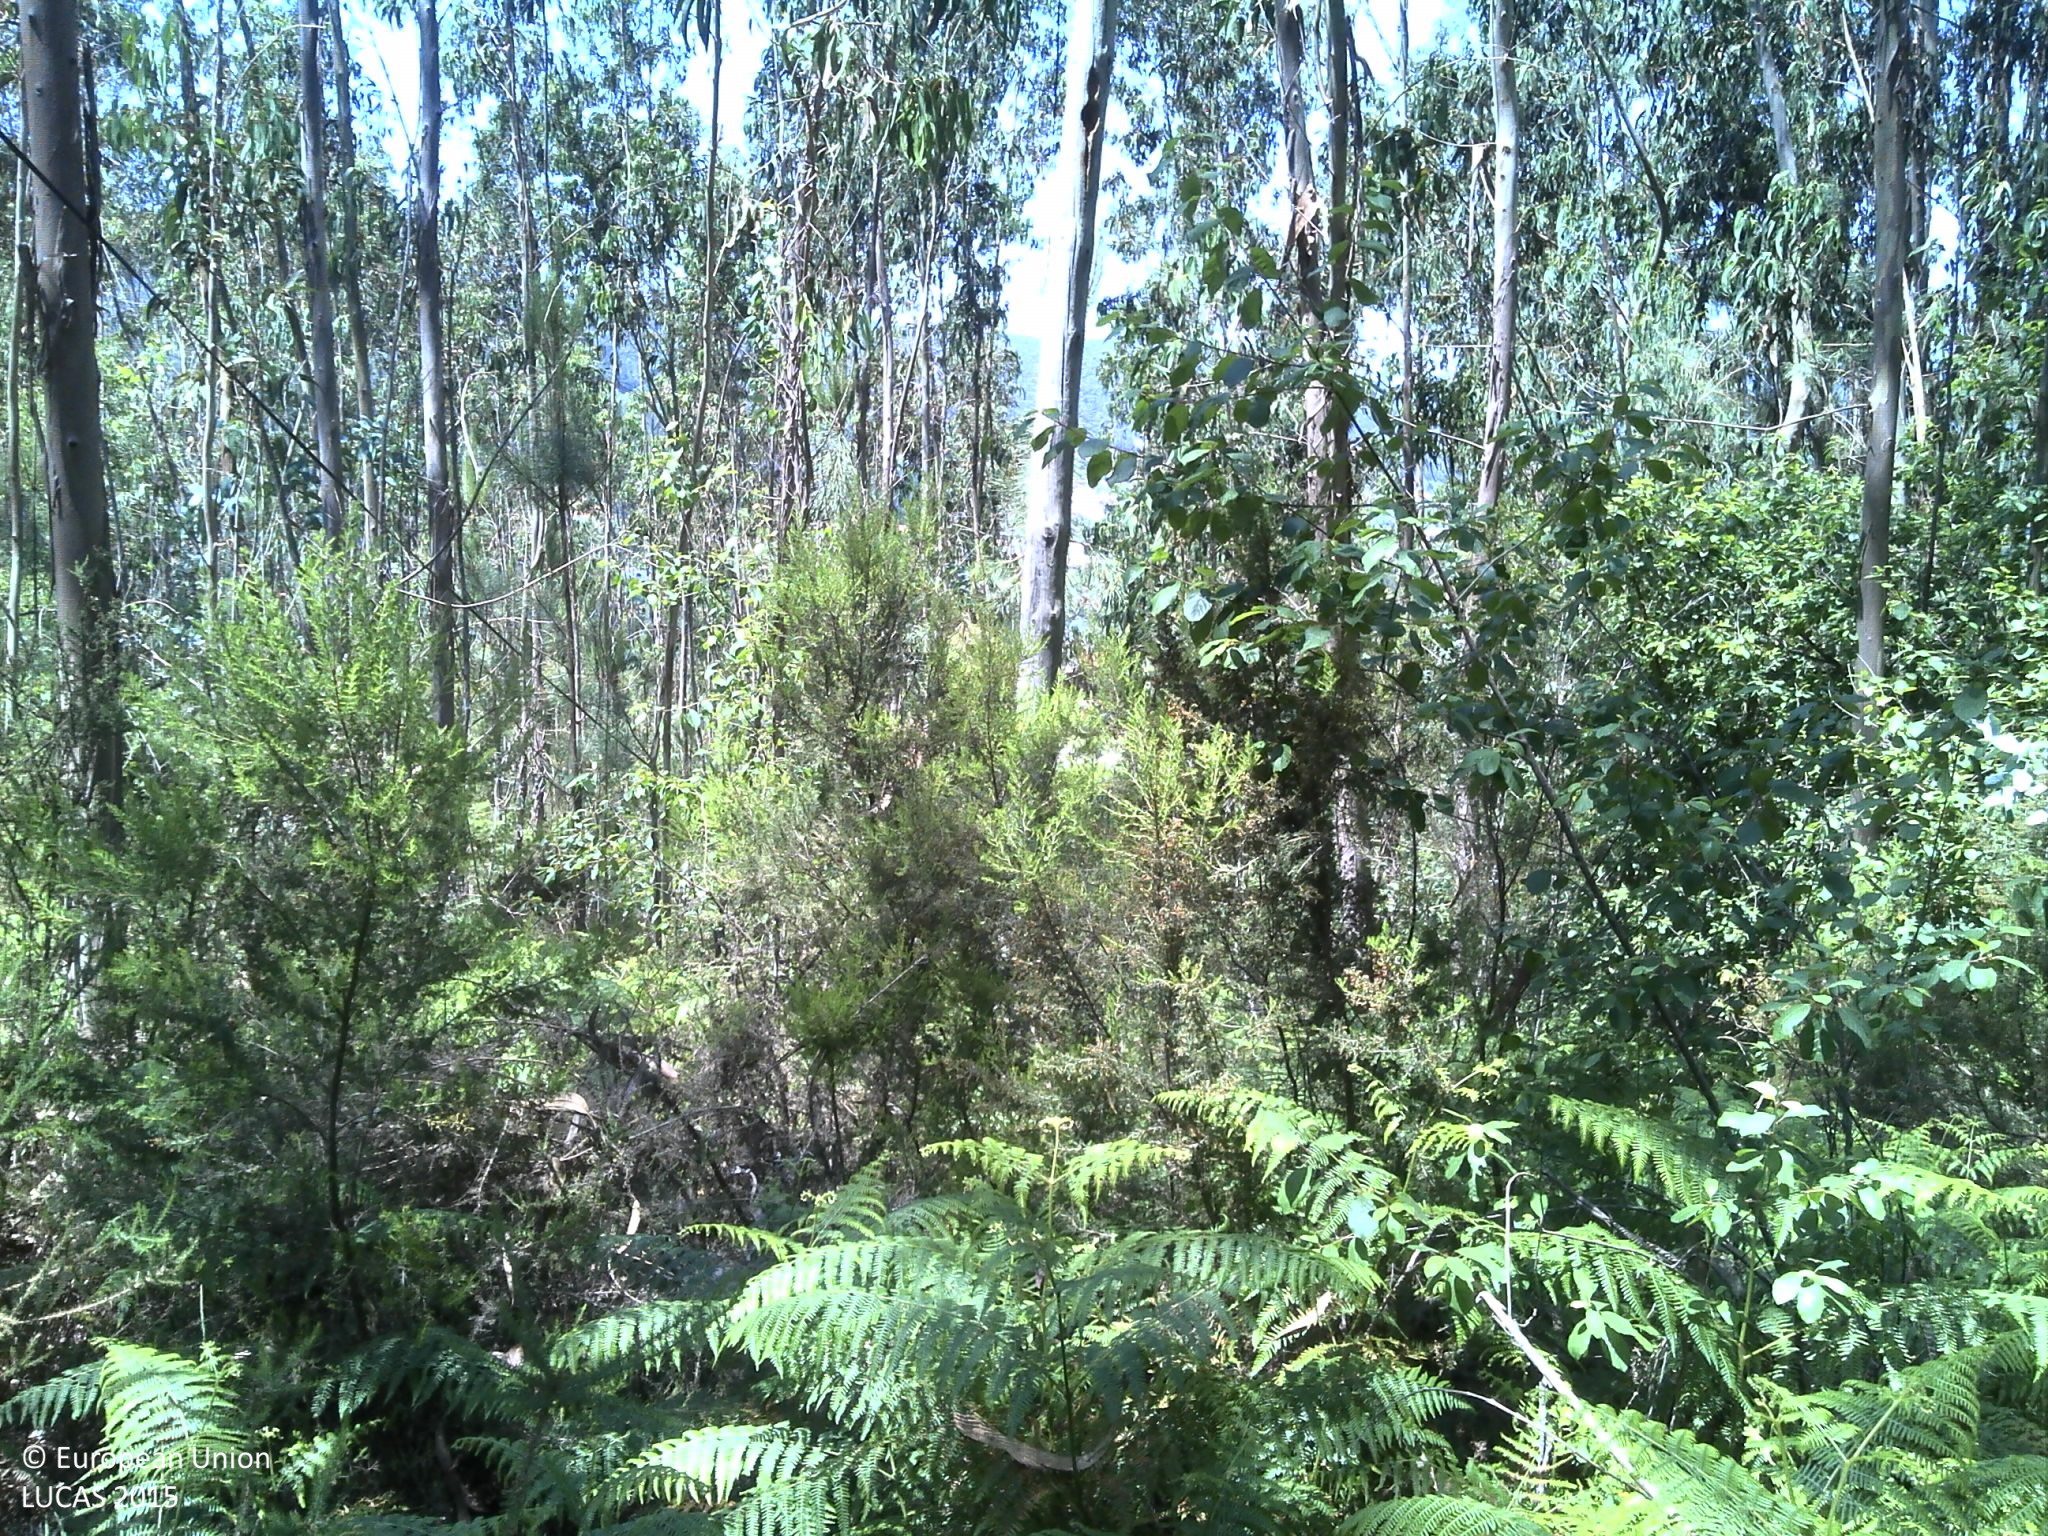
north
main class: Woodland
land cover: Broadleaved woodland
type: exotic forest
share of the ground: 50 - 75 %
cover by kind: broadleaved forest trees 55 %, shrubs 30 %, herbaceous plants 10 %, unconsolidated bare surface 5 %
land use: Forestry
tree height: > 5 m
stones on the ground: < 10 %
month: June
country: PT
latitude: 40.7495
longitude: -8.3904
